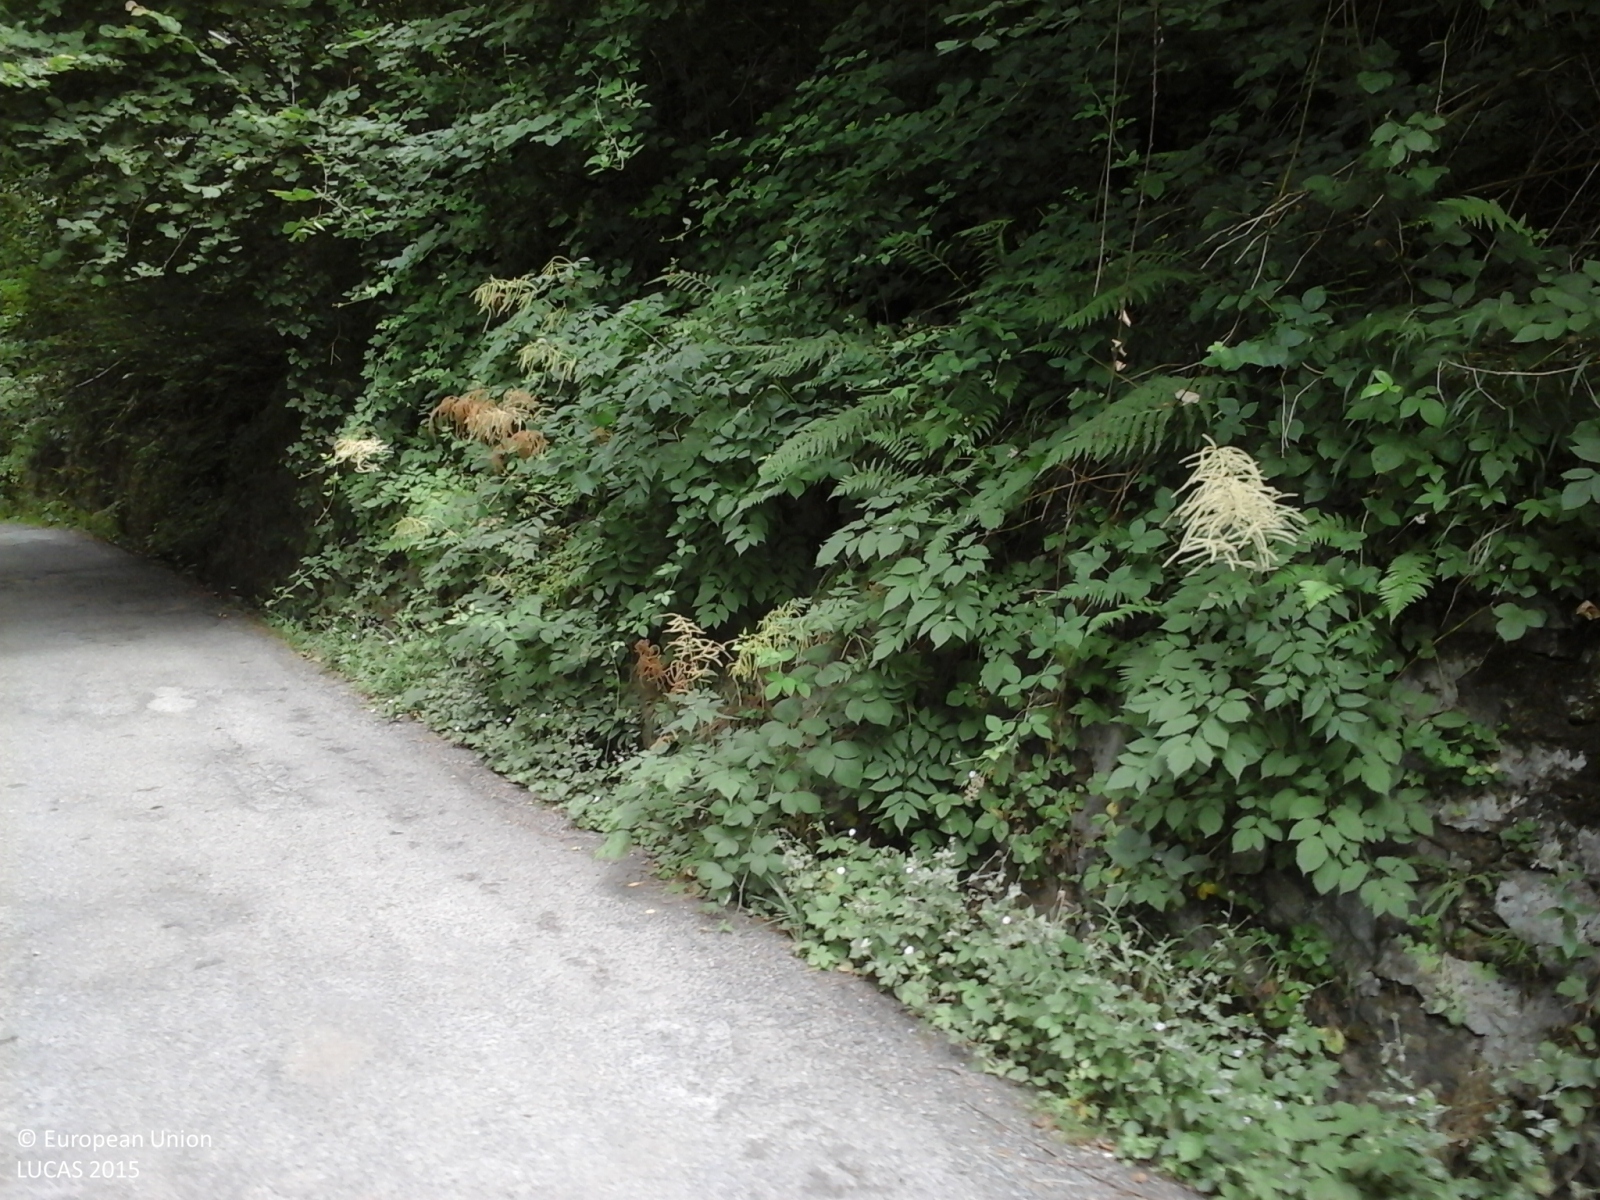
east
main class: Woodland
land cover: Broadleaved woodland
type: beech forest
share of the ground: > 75 %
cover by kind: broadleaved forest trees 100 %
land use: Semi-natural and natural areas not in use
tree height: > 5 m
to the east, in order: Broadleaved woodland; Electric lines; Broadleaved woodland; Tracks; Broadleaved woodland; Grassland with sparse tree/shrub cover; Paved roads, cycling and walking lanes; Rivers and streams; Grassland without tree/shrub cover; Broadleaved woodland; Grassland without tree/shrub cover
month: July
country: IT
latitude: 44.9097
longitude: 7.2563
